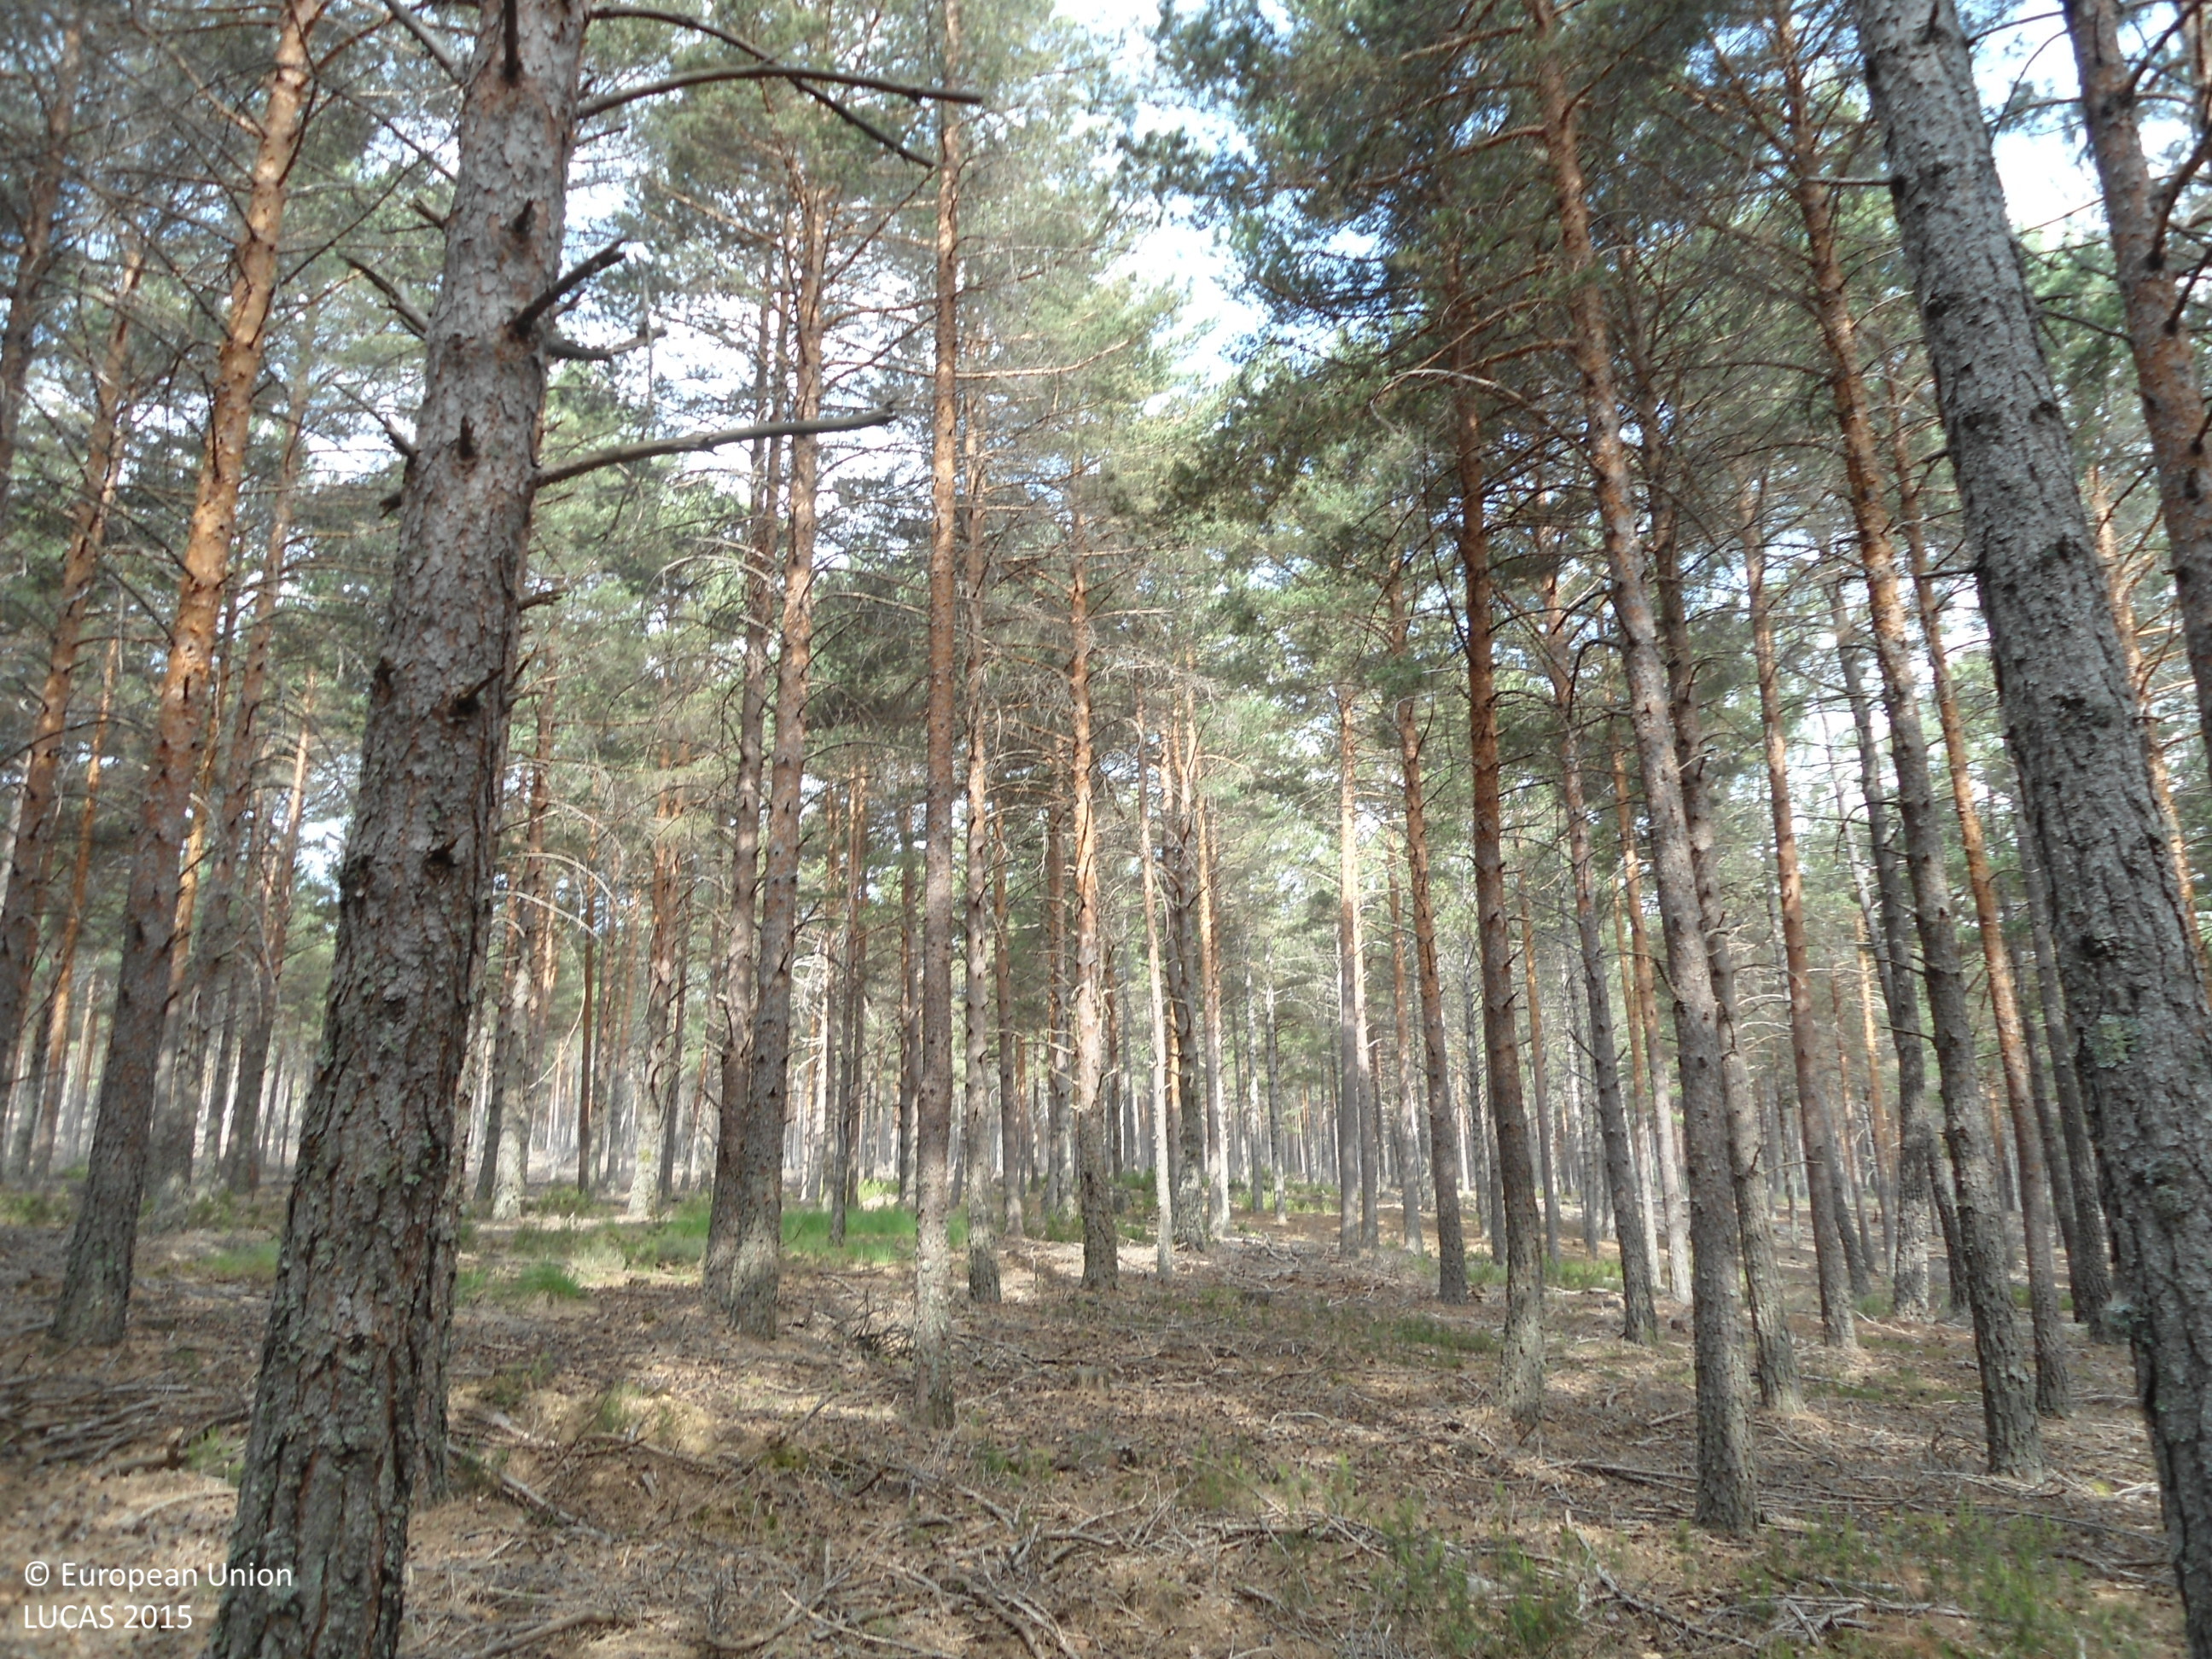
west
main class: Woodland
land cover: Pine dominated coniferous woodland
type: coniferous forest of the mediterranean region
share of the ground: > 75 %
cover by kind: coniferous forest trees 100 %
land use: Forestry
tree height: > 5 m
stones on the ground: < 10 %
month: June
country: ES
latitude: 41.9924
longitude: -6.5892
